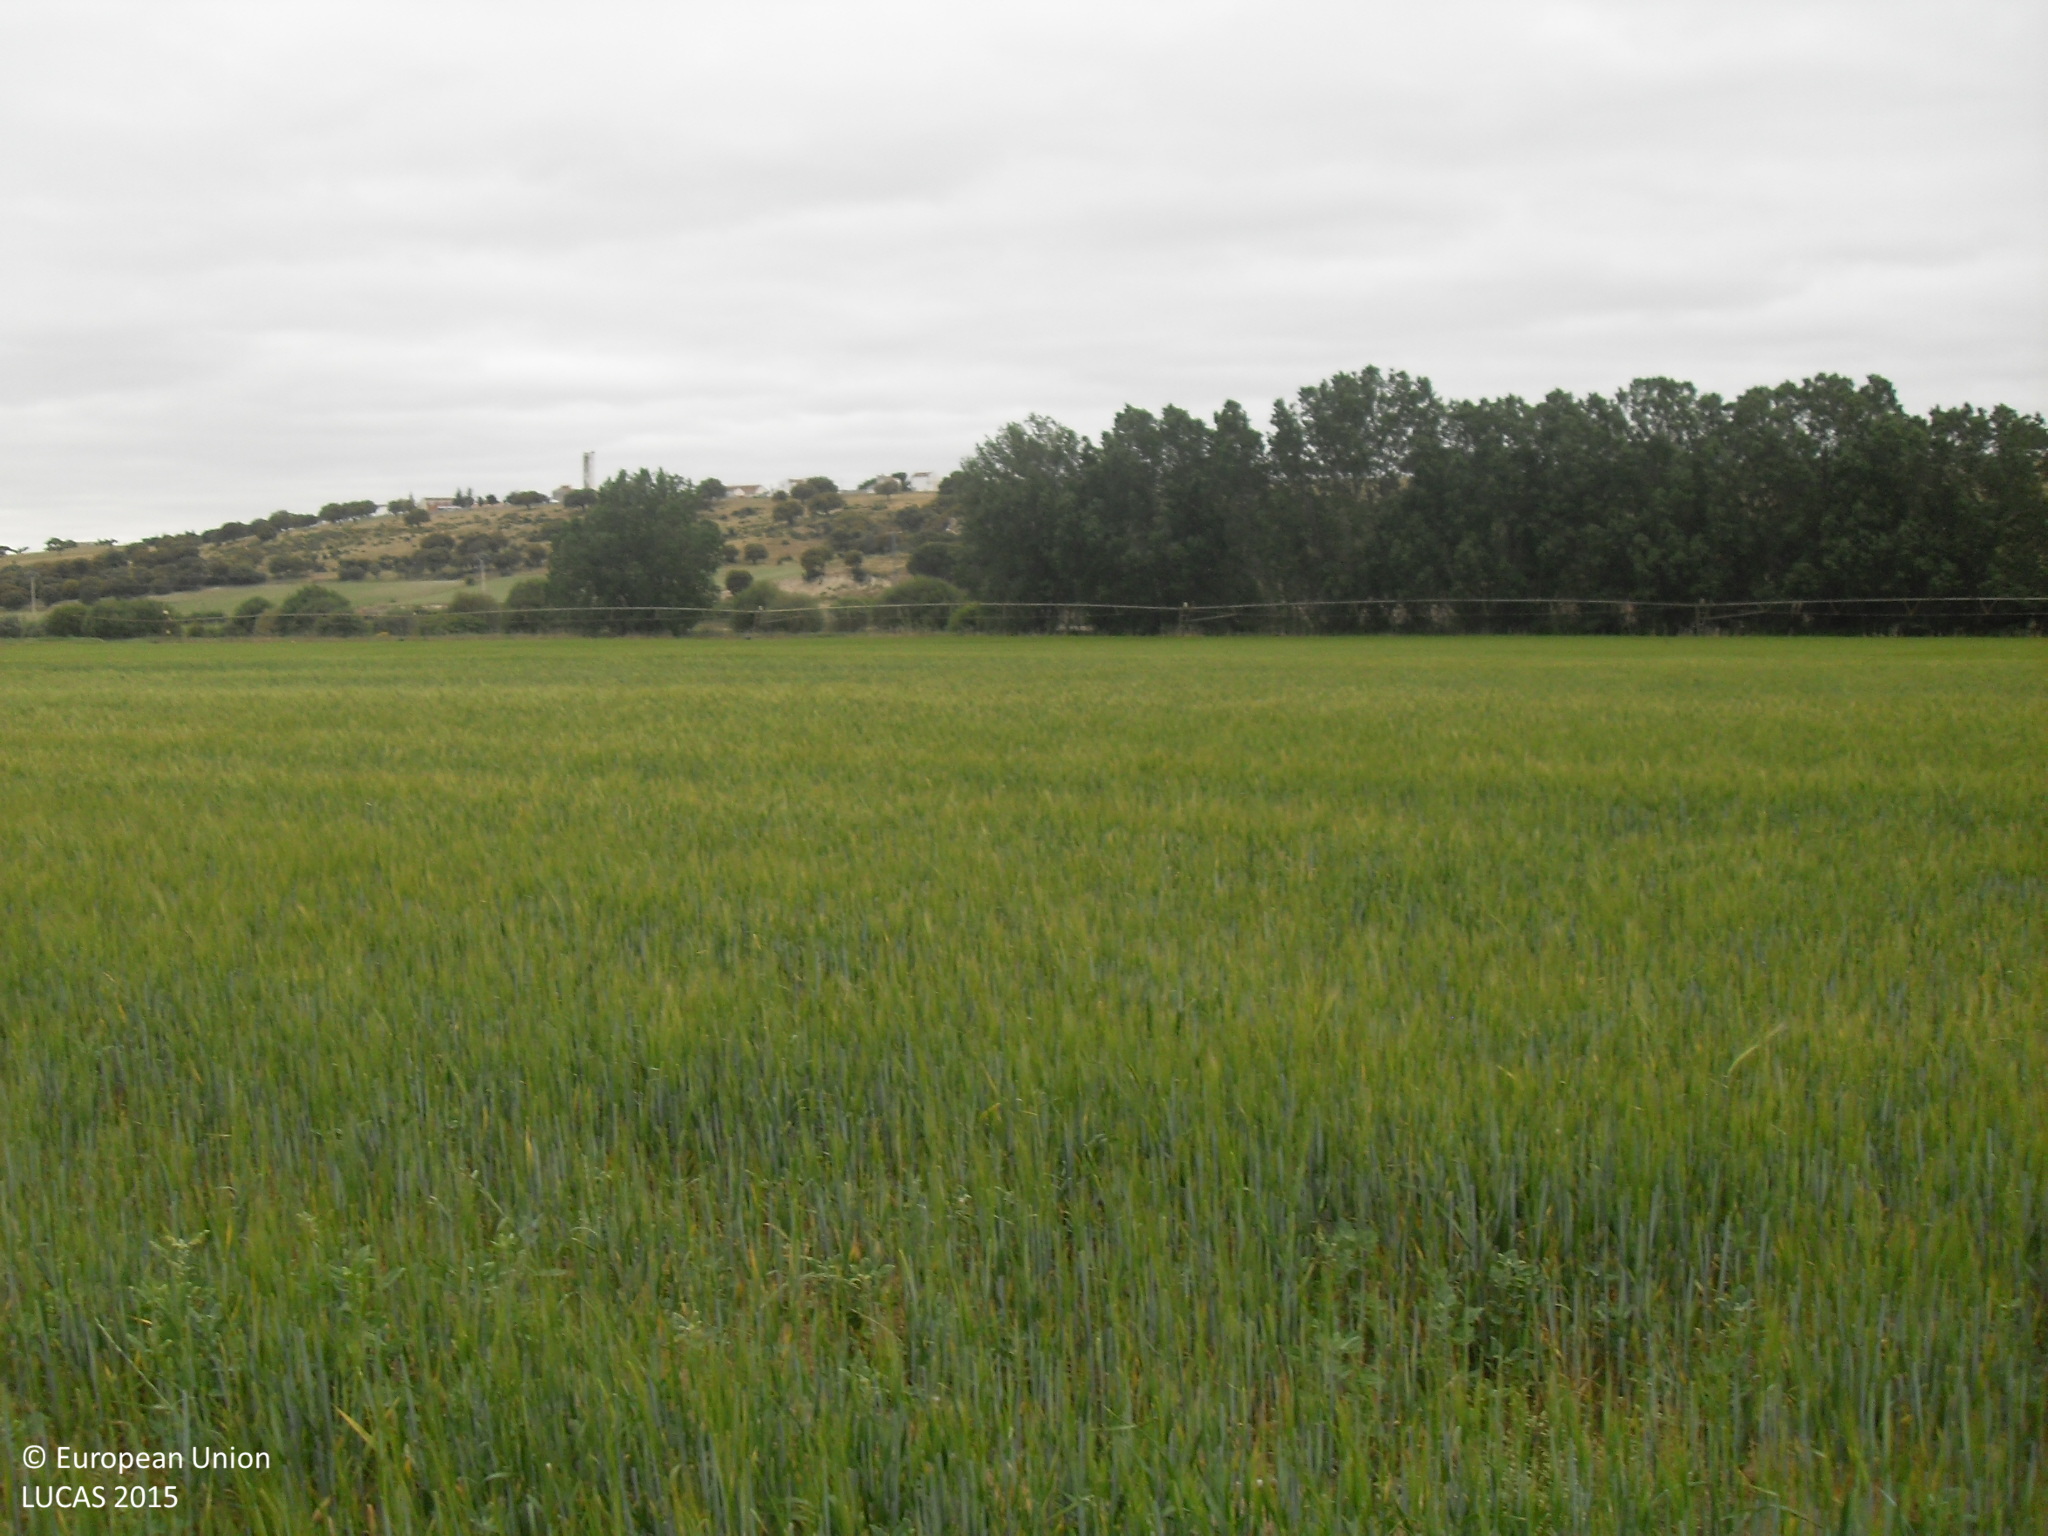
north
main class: Cropland
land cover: Barley
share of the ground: > 75 %
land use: Agriculture (excluding fallow land and kitchen gardens)
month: May
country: ES
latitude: 40.6750
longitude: -5.6537
